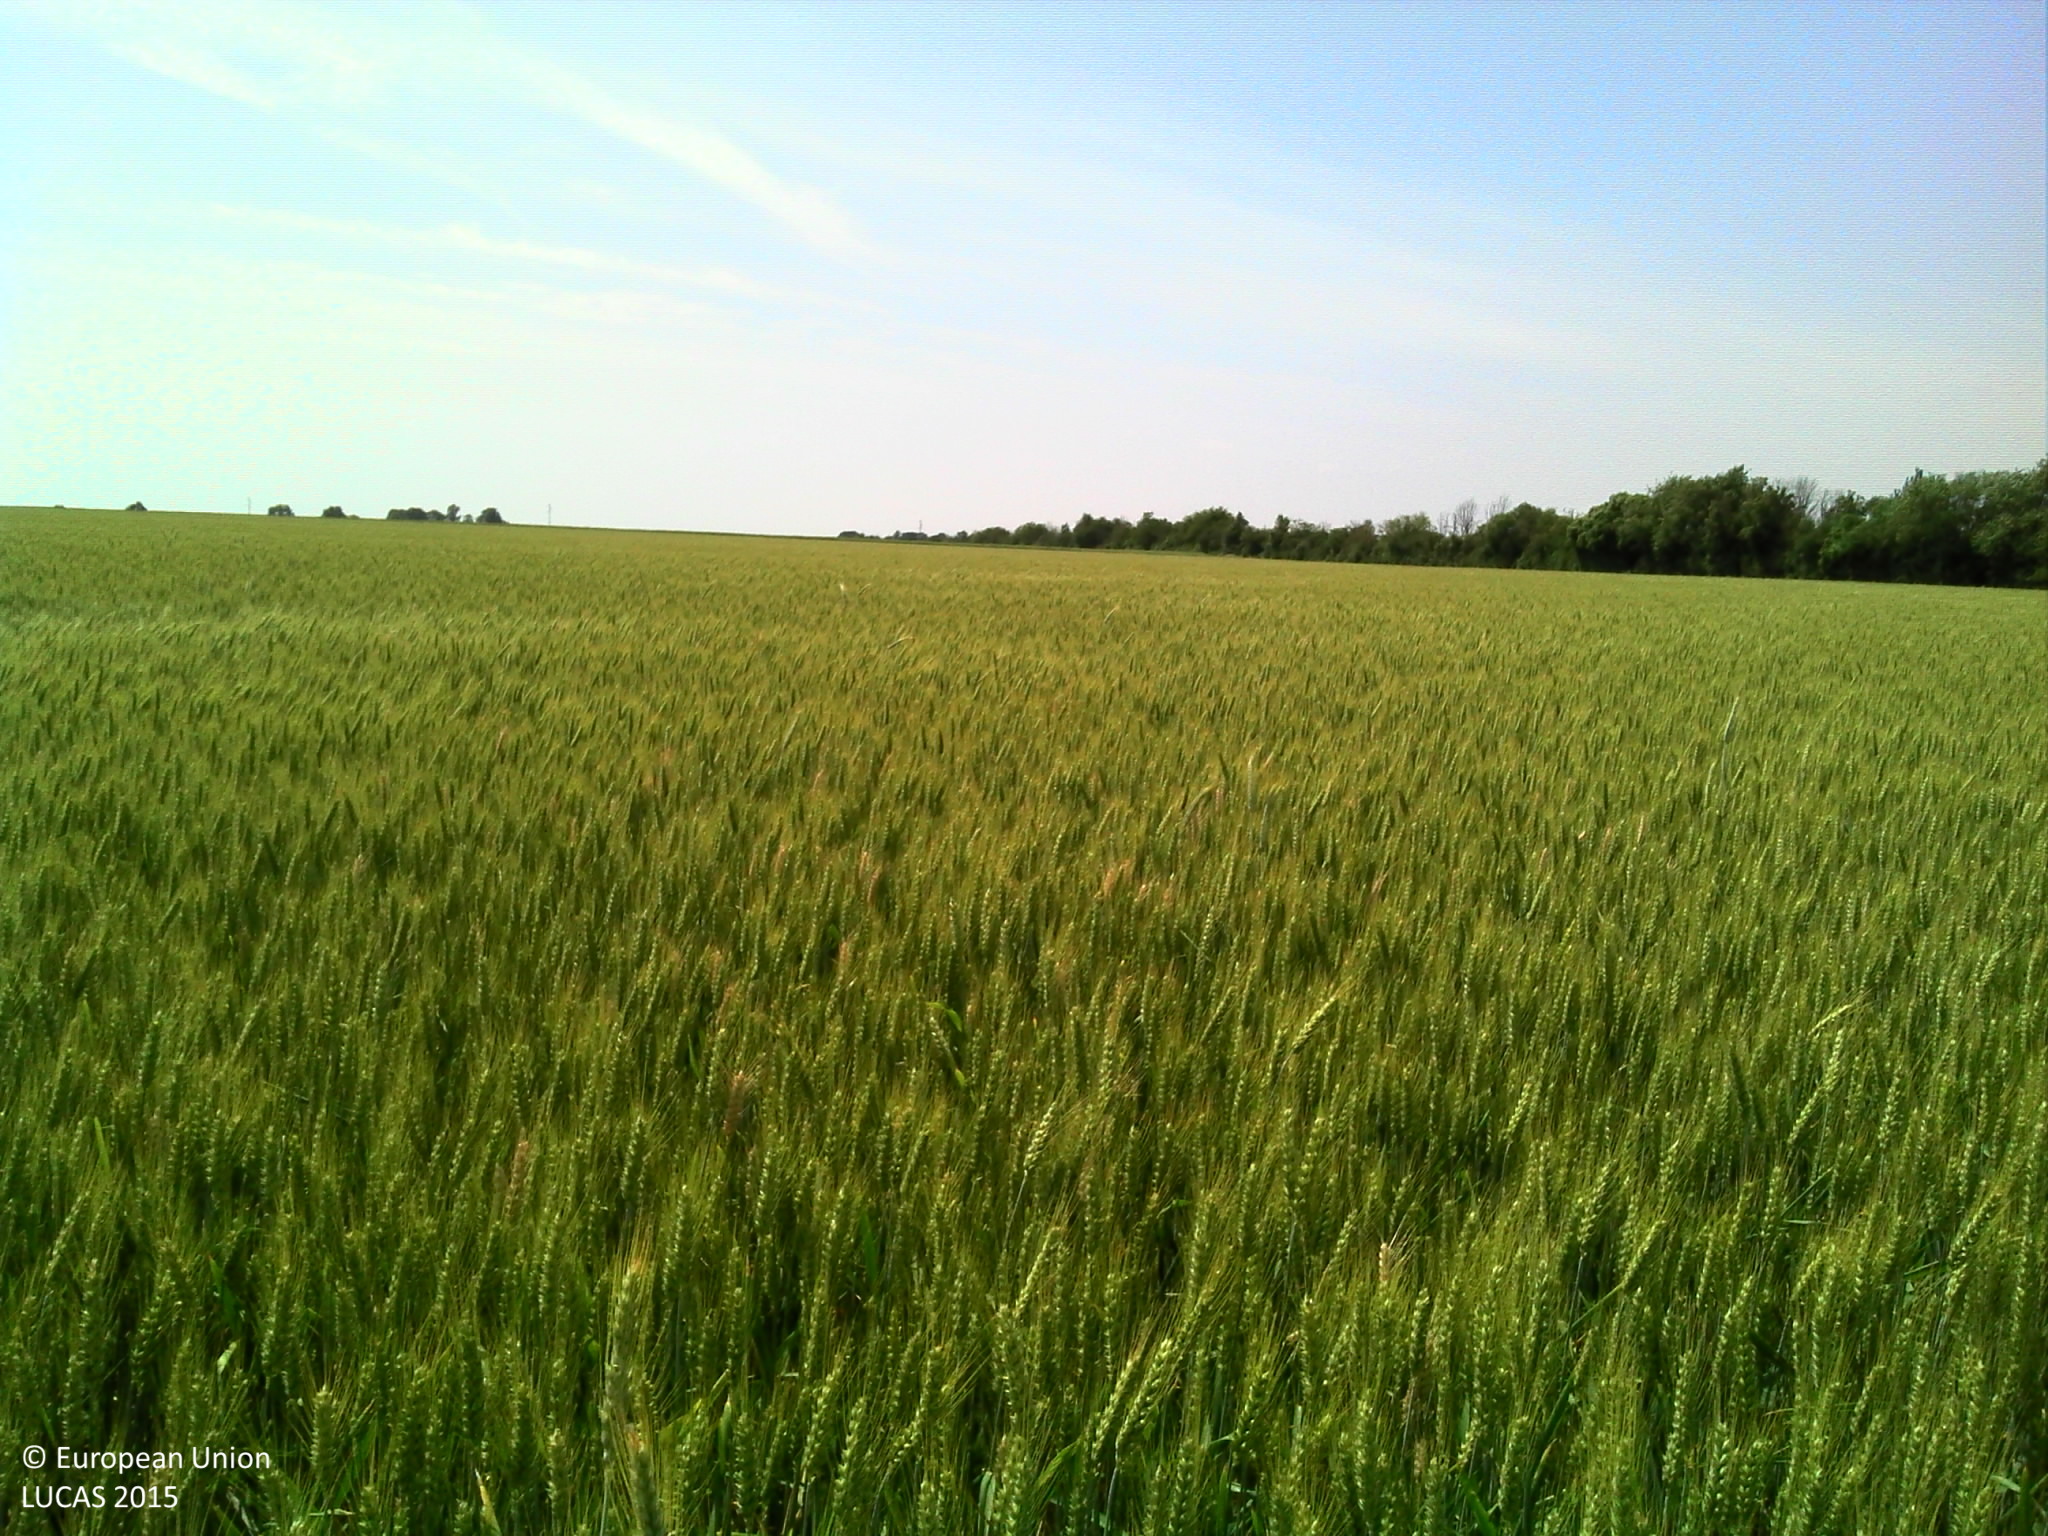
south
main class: Cropland
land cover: Common wheat
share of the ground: > 75 %
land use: Agriculture (excluding fallow land and kitchen gardens)
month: June
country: FR
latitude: 46.9658
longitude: 2.6474
